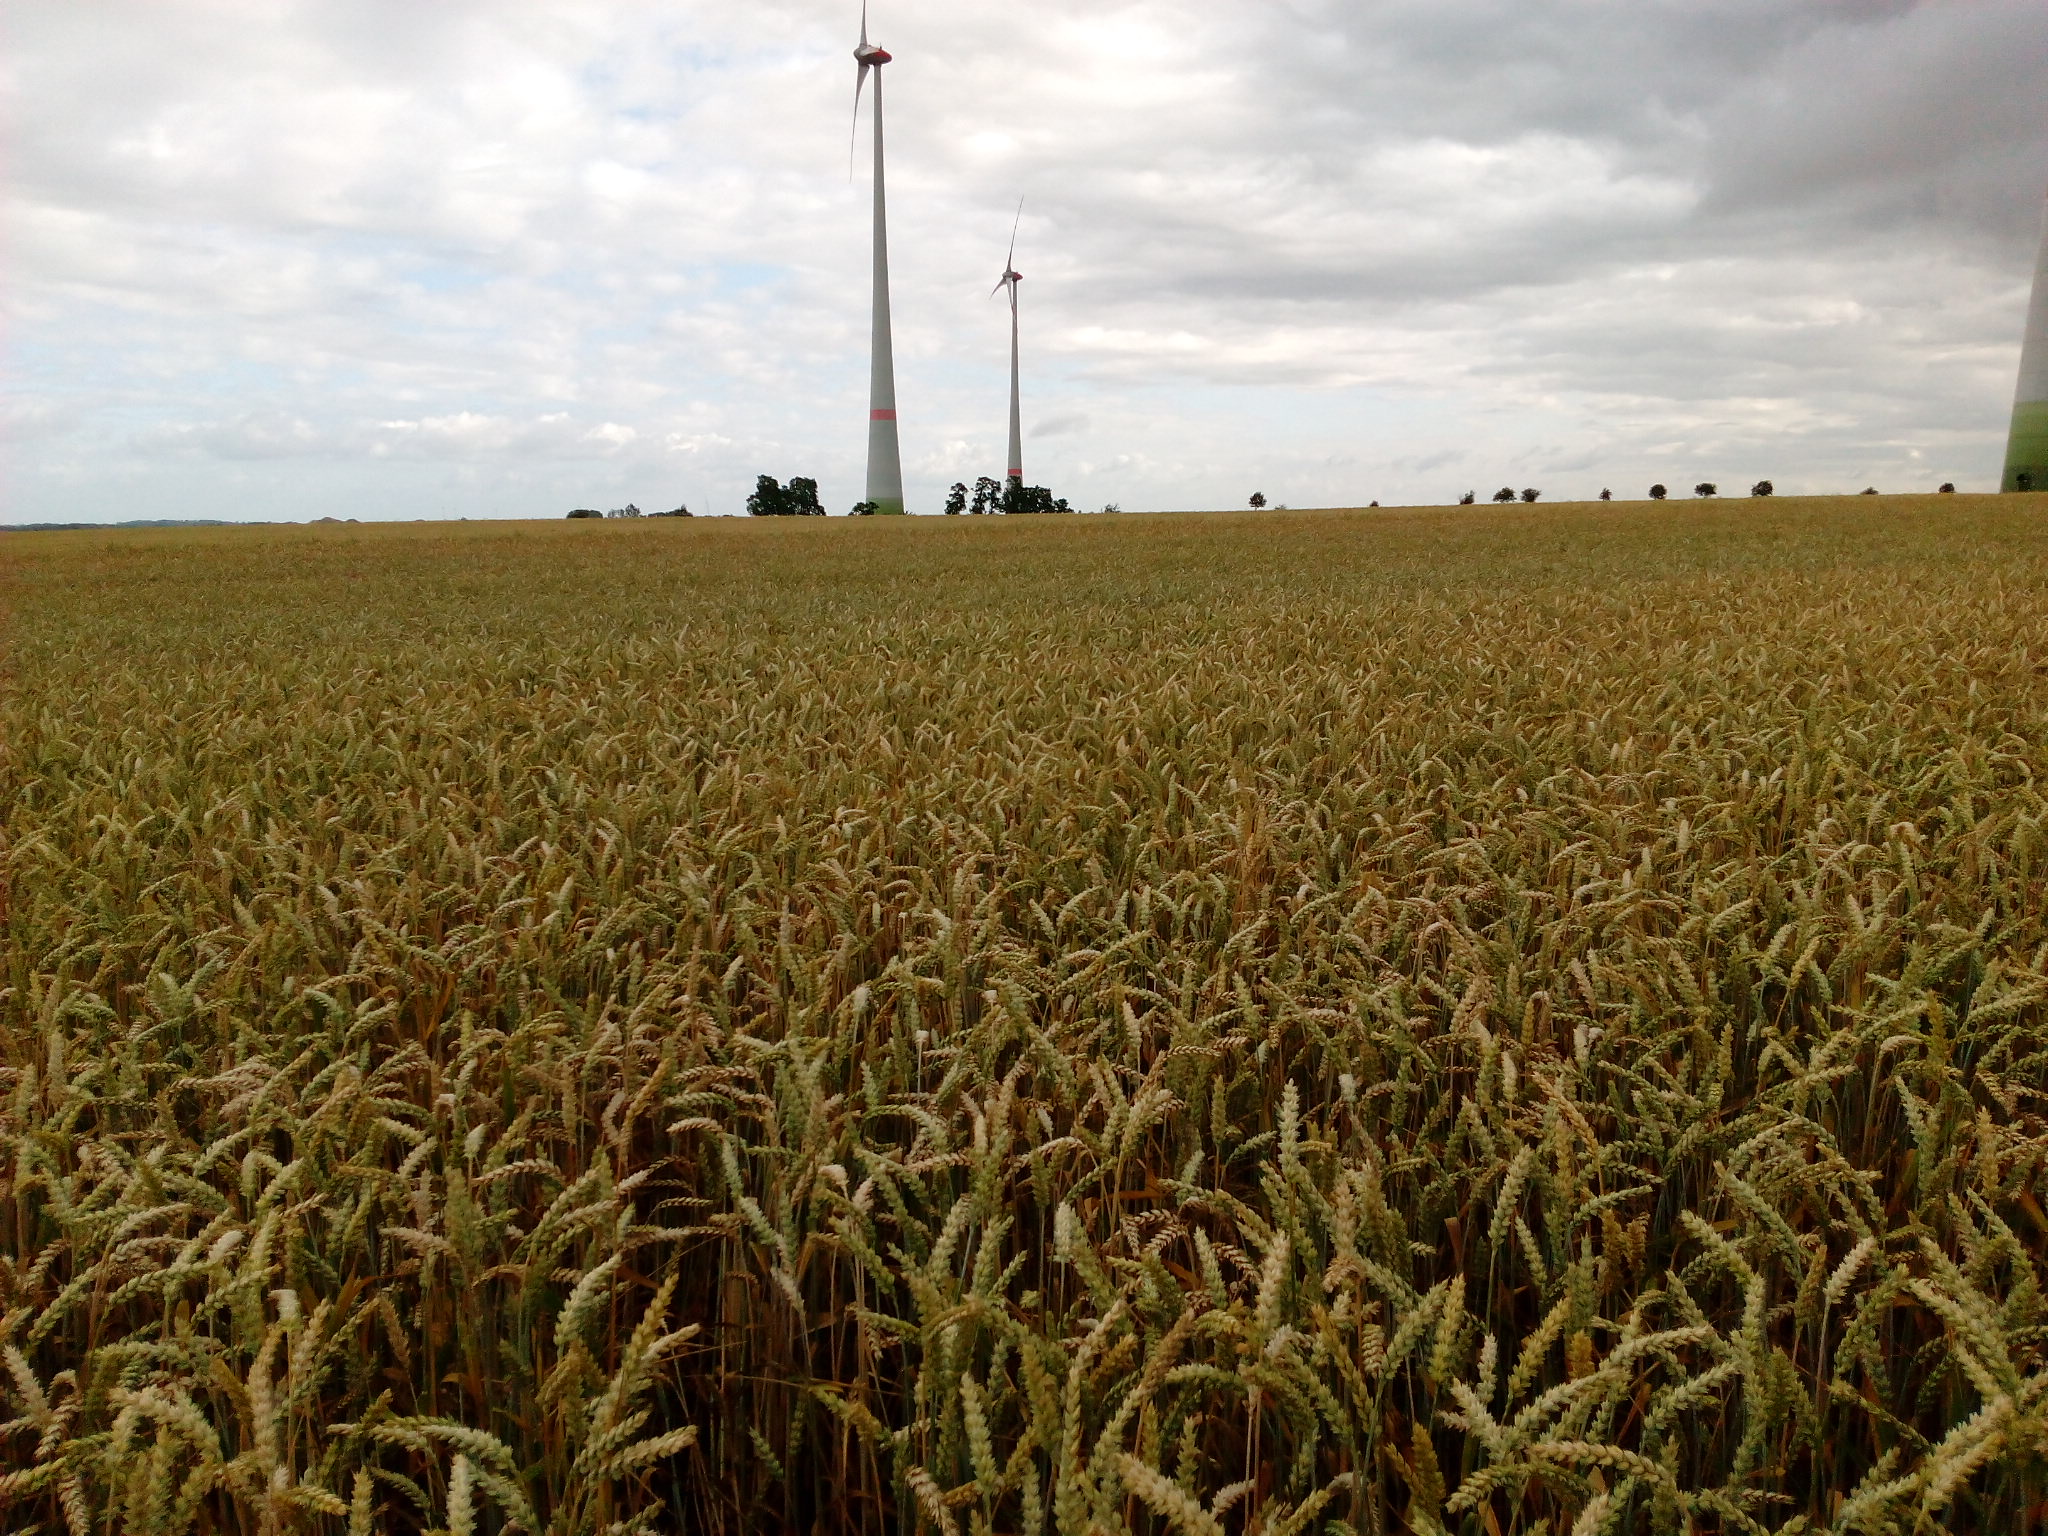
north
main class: Cropland
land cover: Common wheat
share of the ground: > 75 %
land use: Agriculture (excluding fallow land and kitchen gardens)
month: July
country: DE
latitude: 53.2726
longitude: 14.2745
